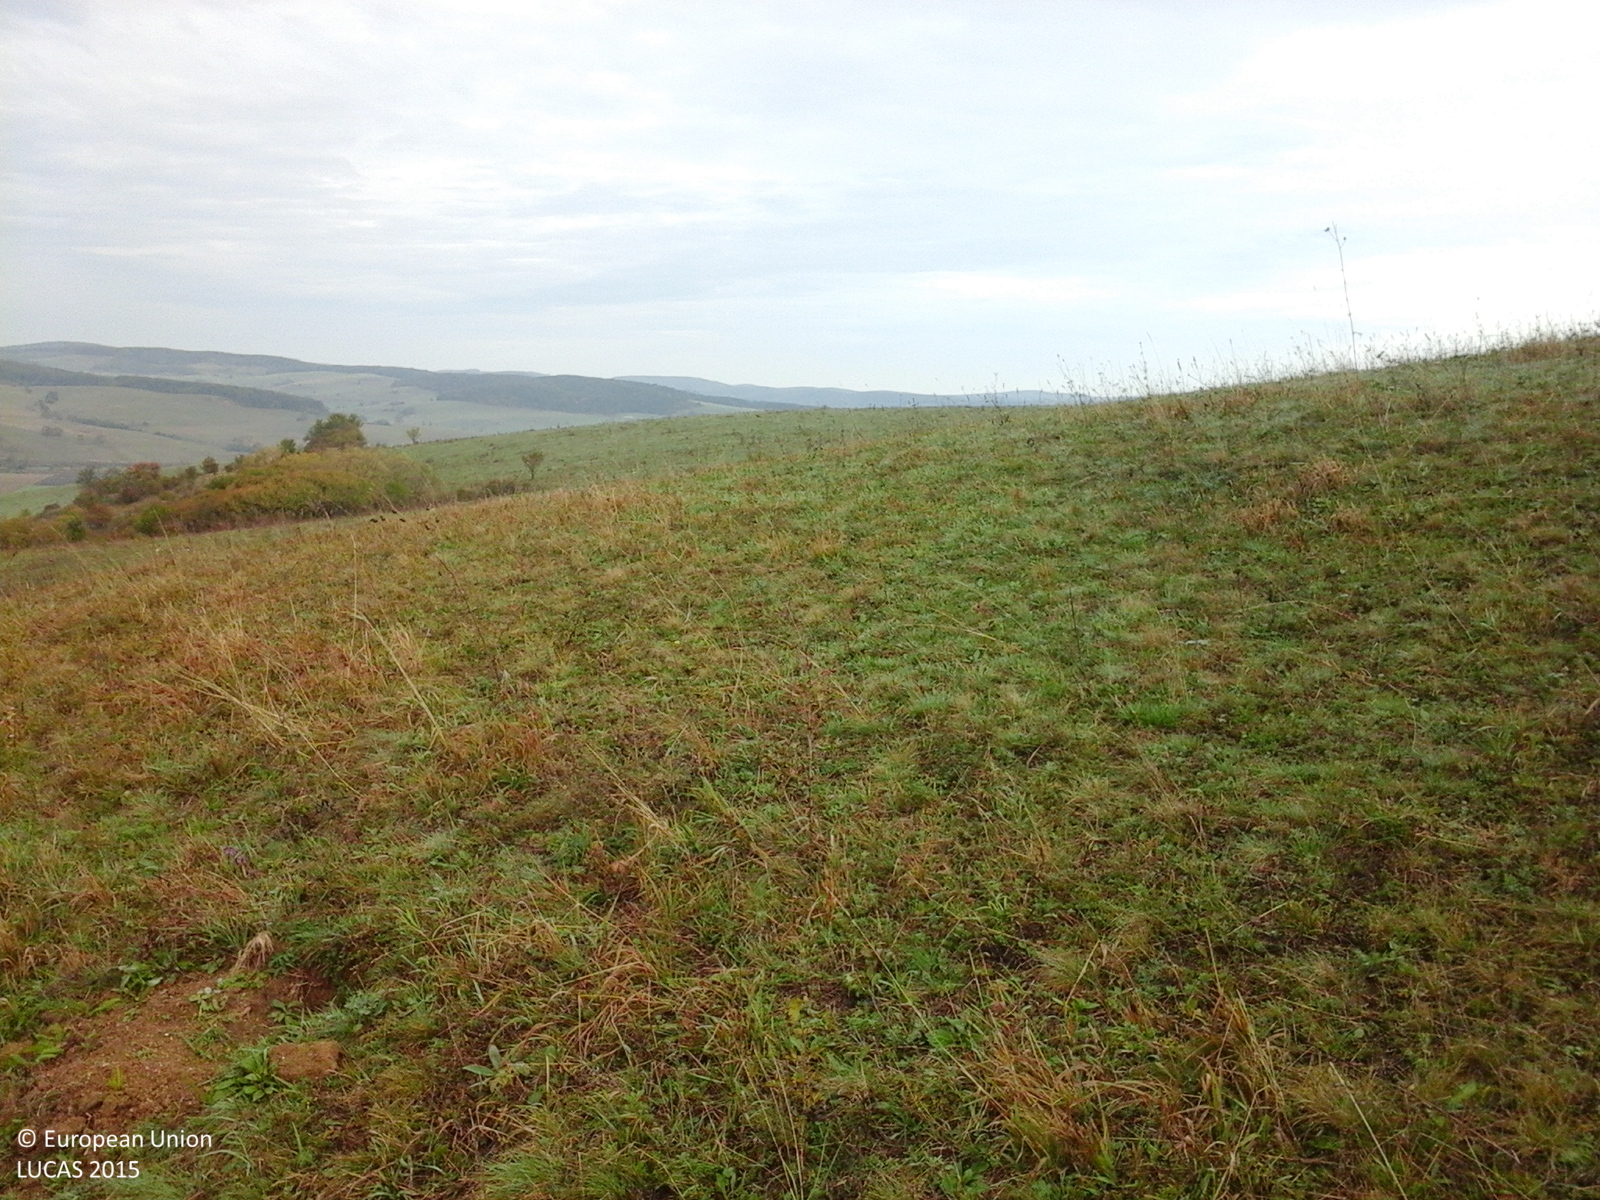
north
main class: Grassland
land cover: Grassland without tree/shrub cover
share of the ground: > 75 %
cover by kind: herbaceous plants 100 %
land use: Agriculture (excluding fallow land and kitchen gardens)
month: October
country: RO
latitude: 45.9890
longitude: 24.6881
